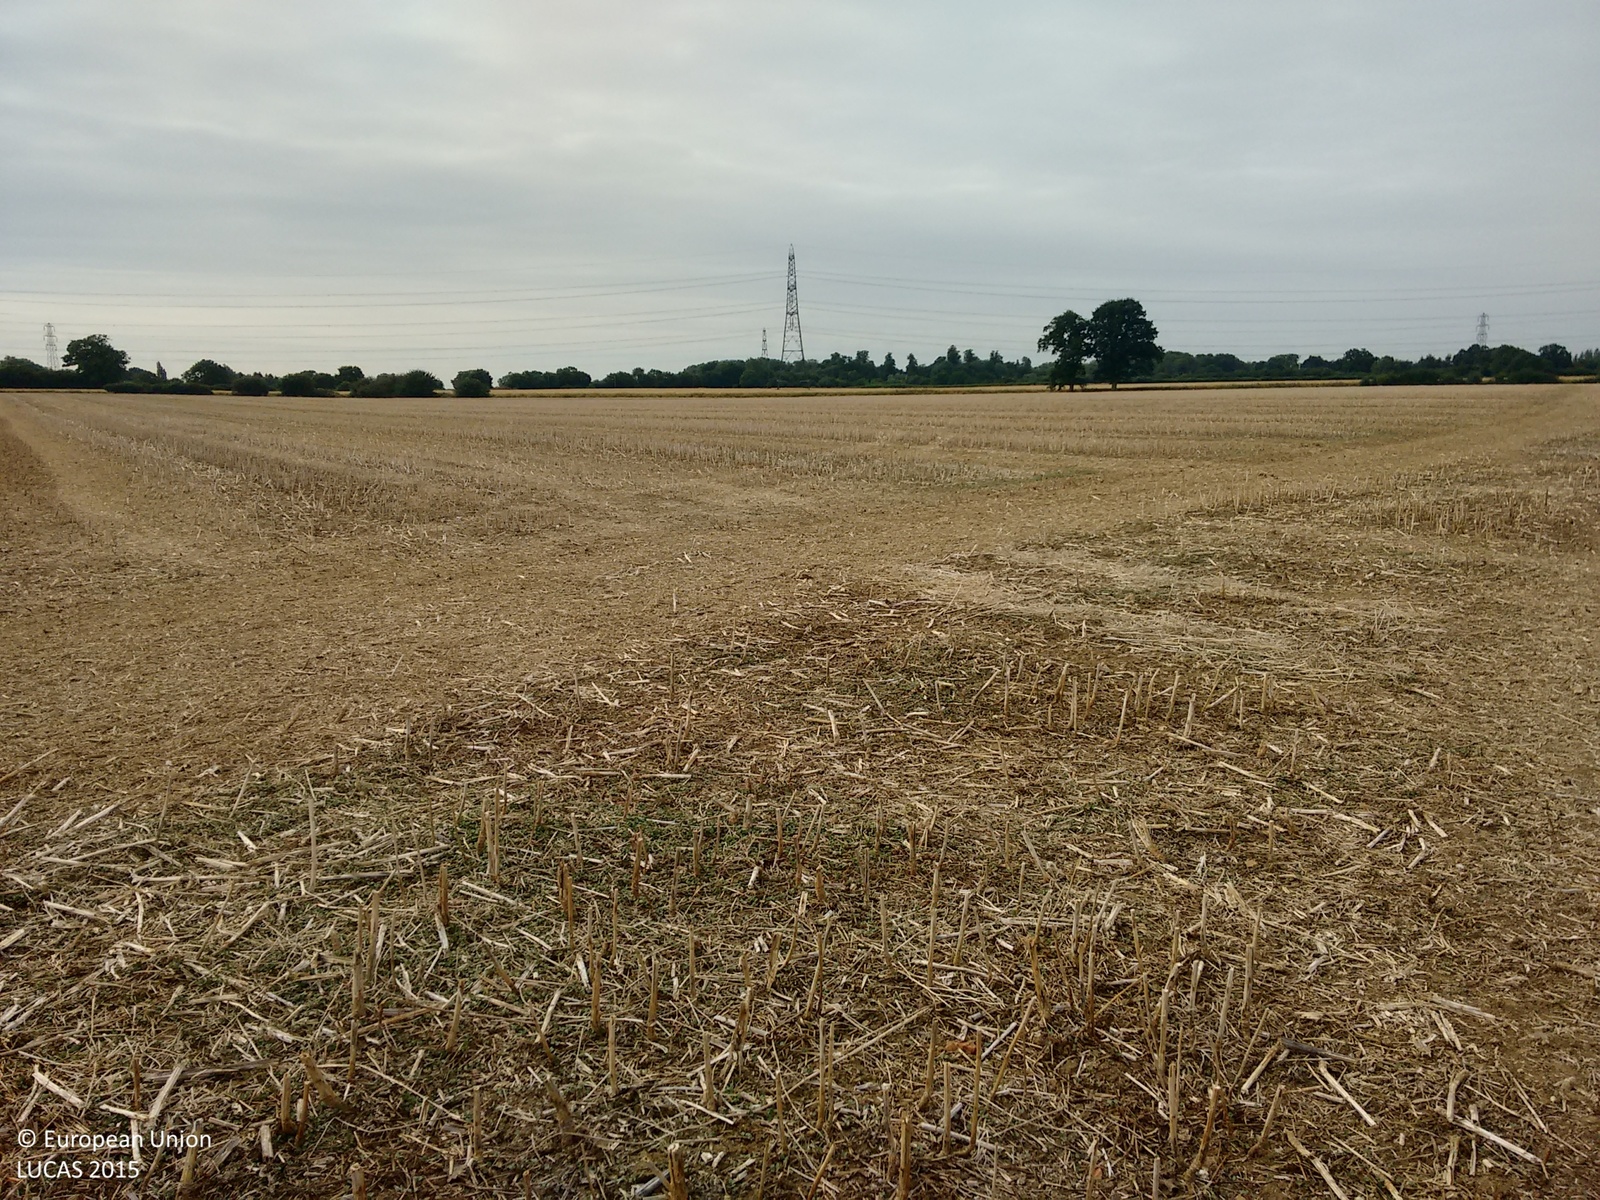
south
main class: Cropland
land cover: Rape and turnip rape
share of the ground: < 10 %
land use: Agriculture (excluding fallow land and kitchen gardens)
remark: Harvested field
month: August
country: GB
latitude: 52.0043
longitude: 0.6065
